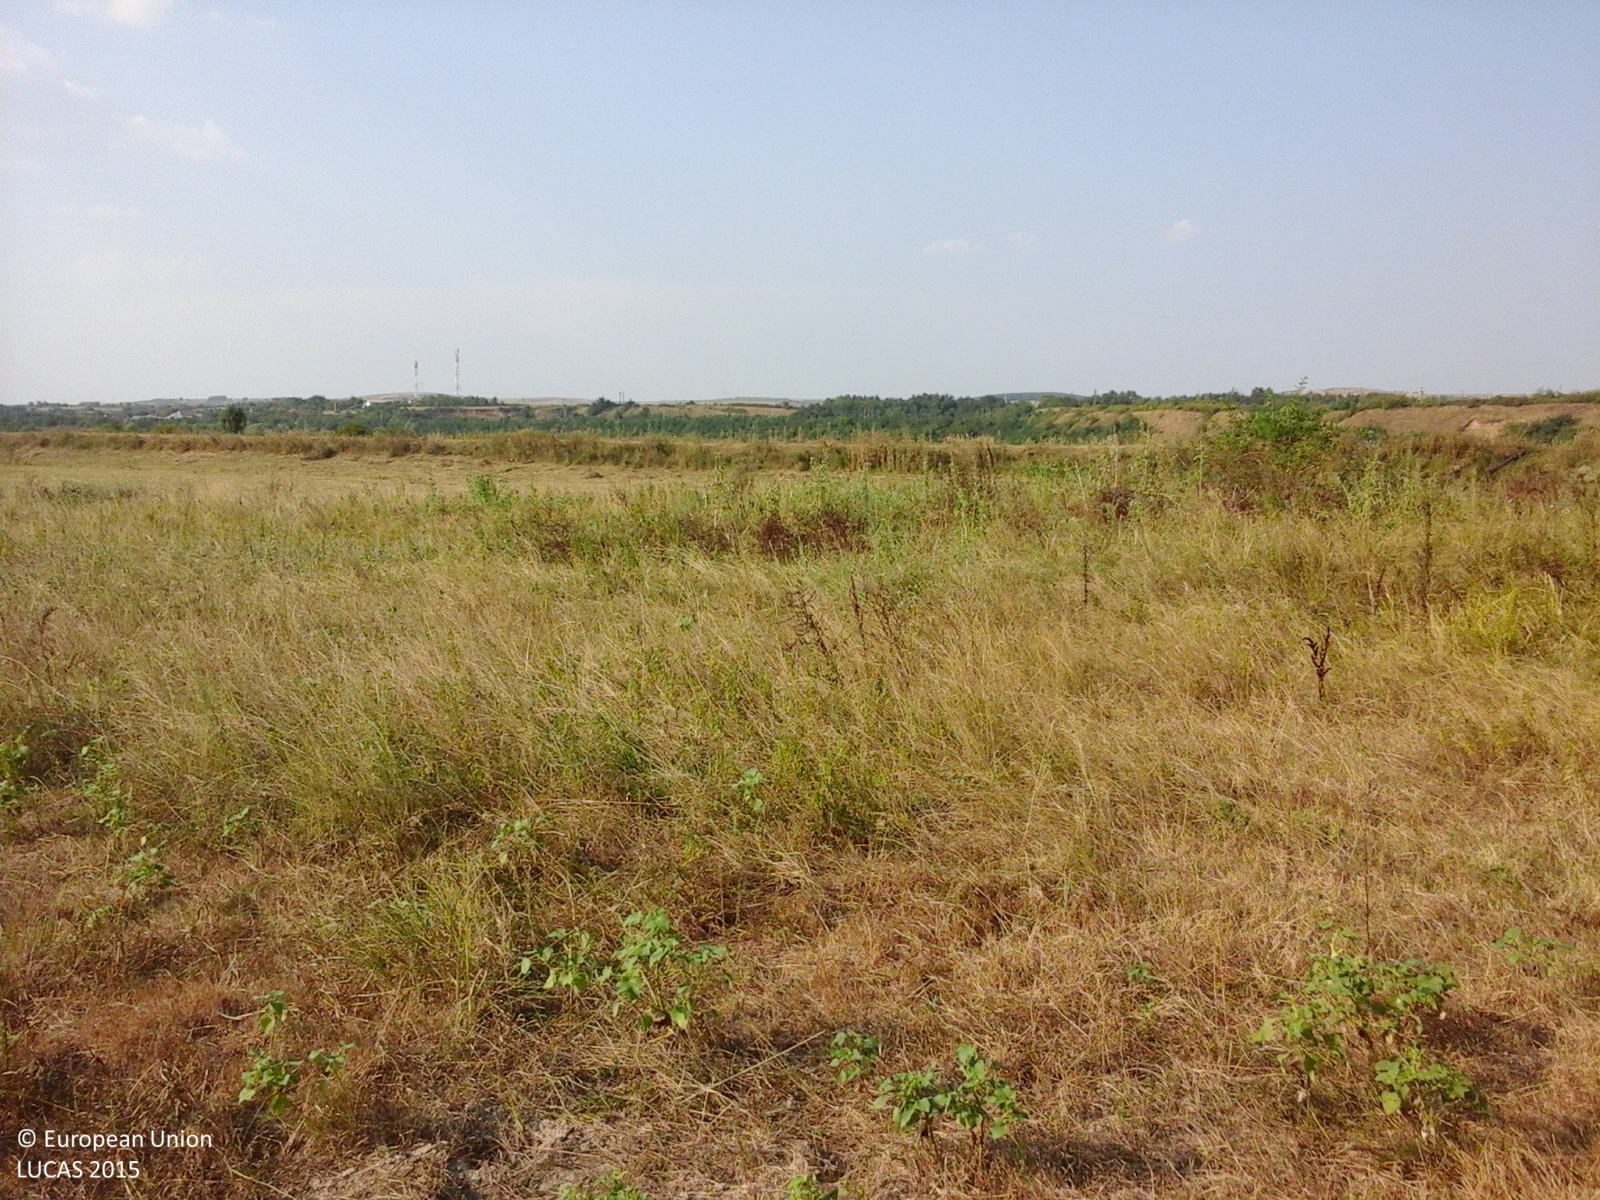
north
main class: Grassland
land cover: Spontaneously vegetated surfaces
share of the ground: > 75 %
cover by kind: herbaceous plants 100 %
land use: Fallow land
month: August
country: RO
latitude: 44.4919
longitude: 23.5984
